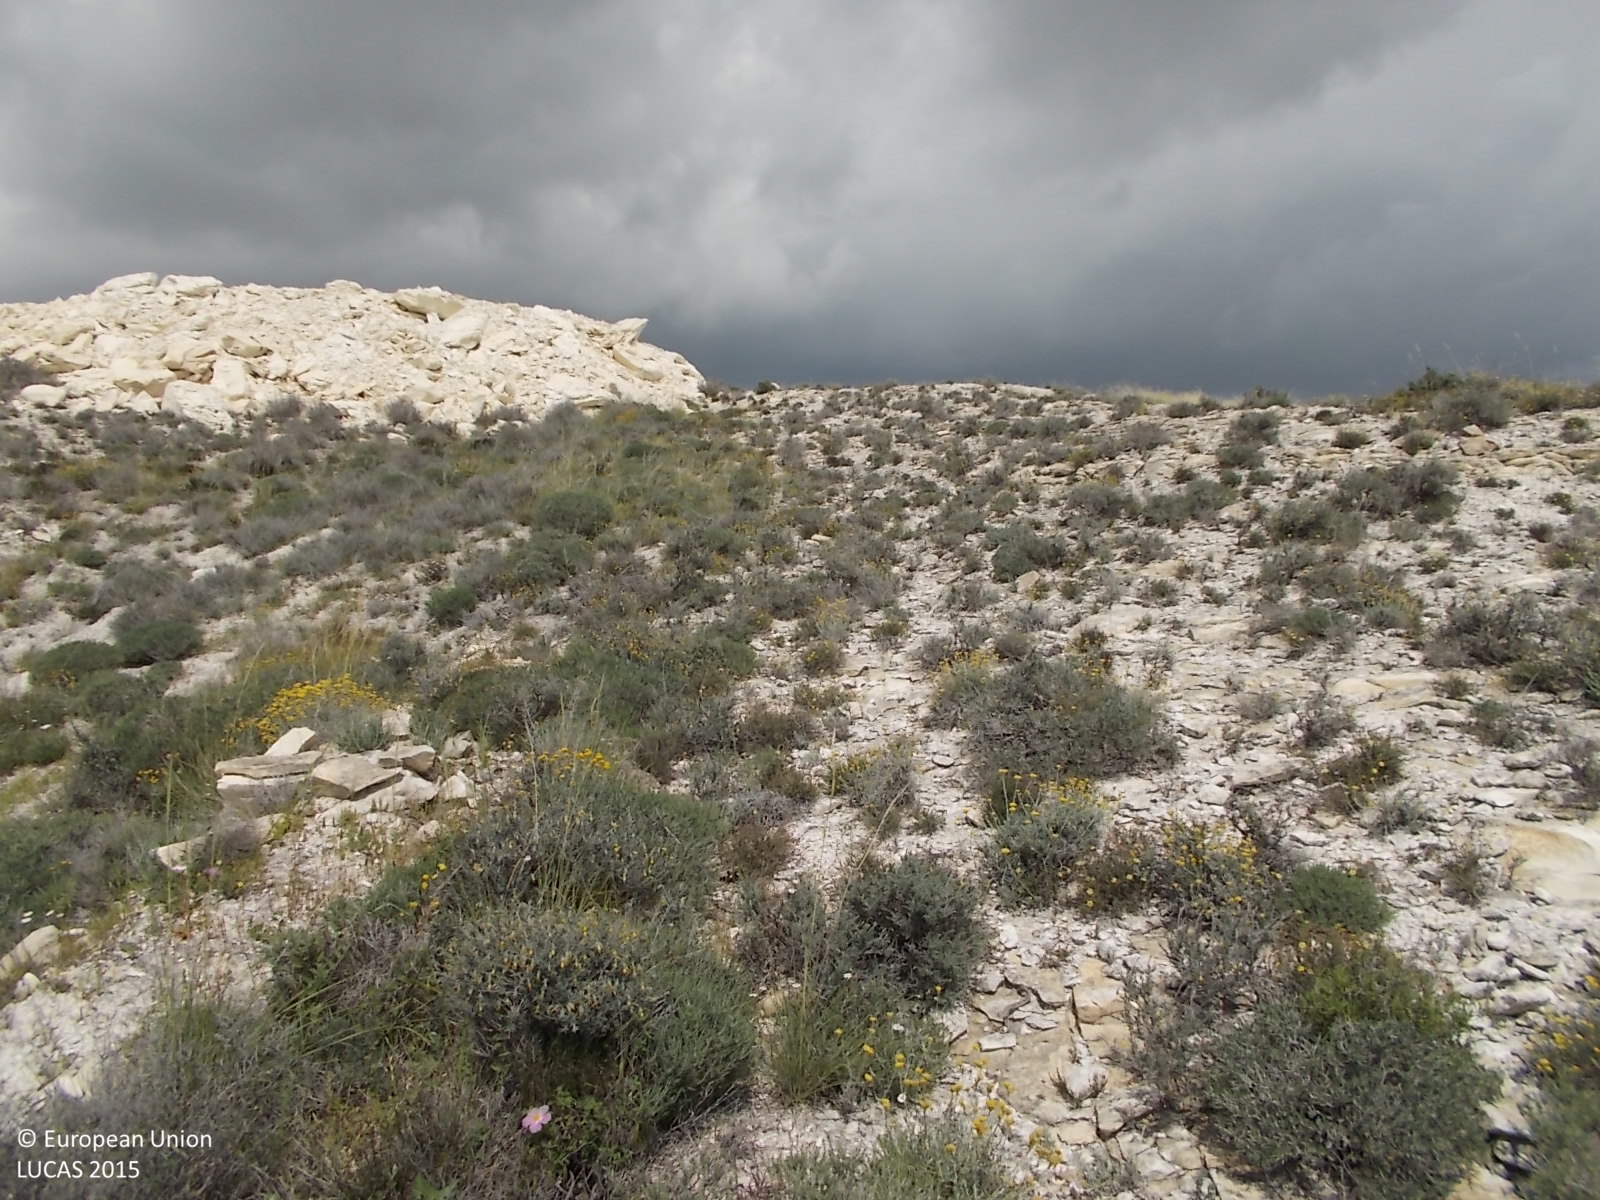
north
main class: Shrubland
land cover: Shrubland without tree cover
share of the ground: 25 - 50 %
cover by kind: shrubs 50 %, unconsolidated bare surface 50 %
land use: Semi-natural and natural areas not in use
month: April
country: CY
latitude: 34.9861
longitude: 33.5629
